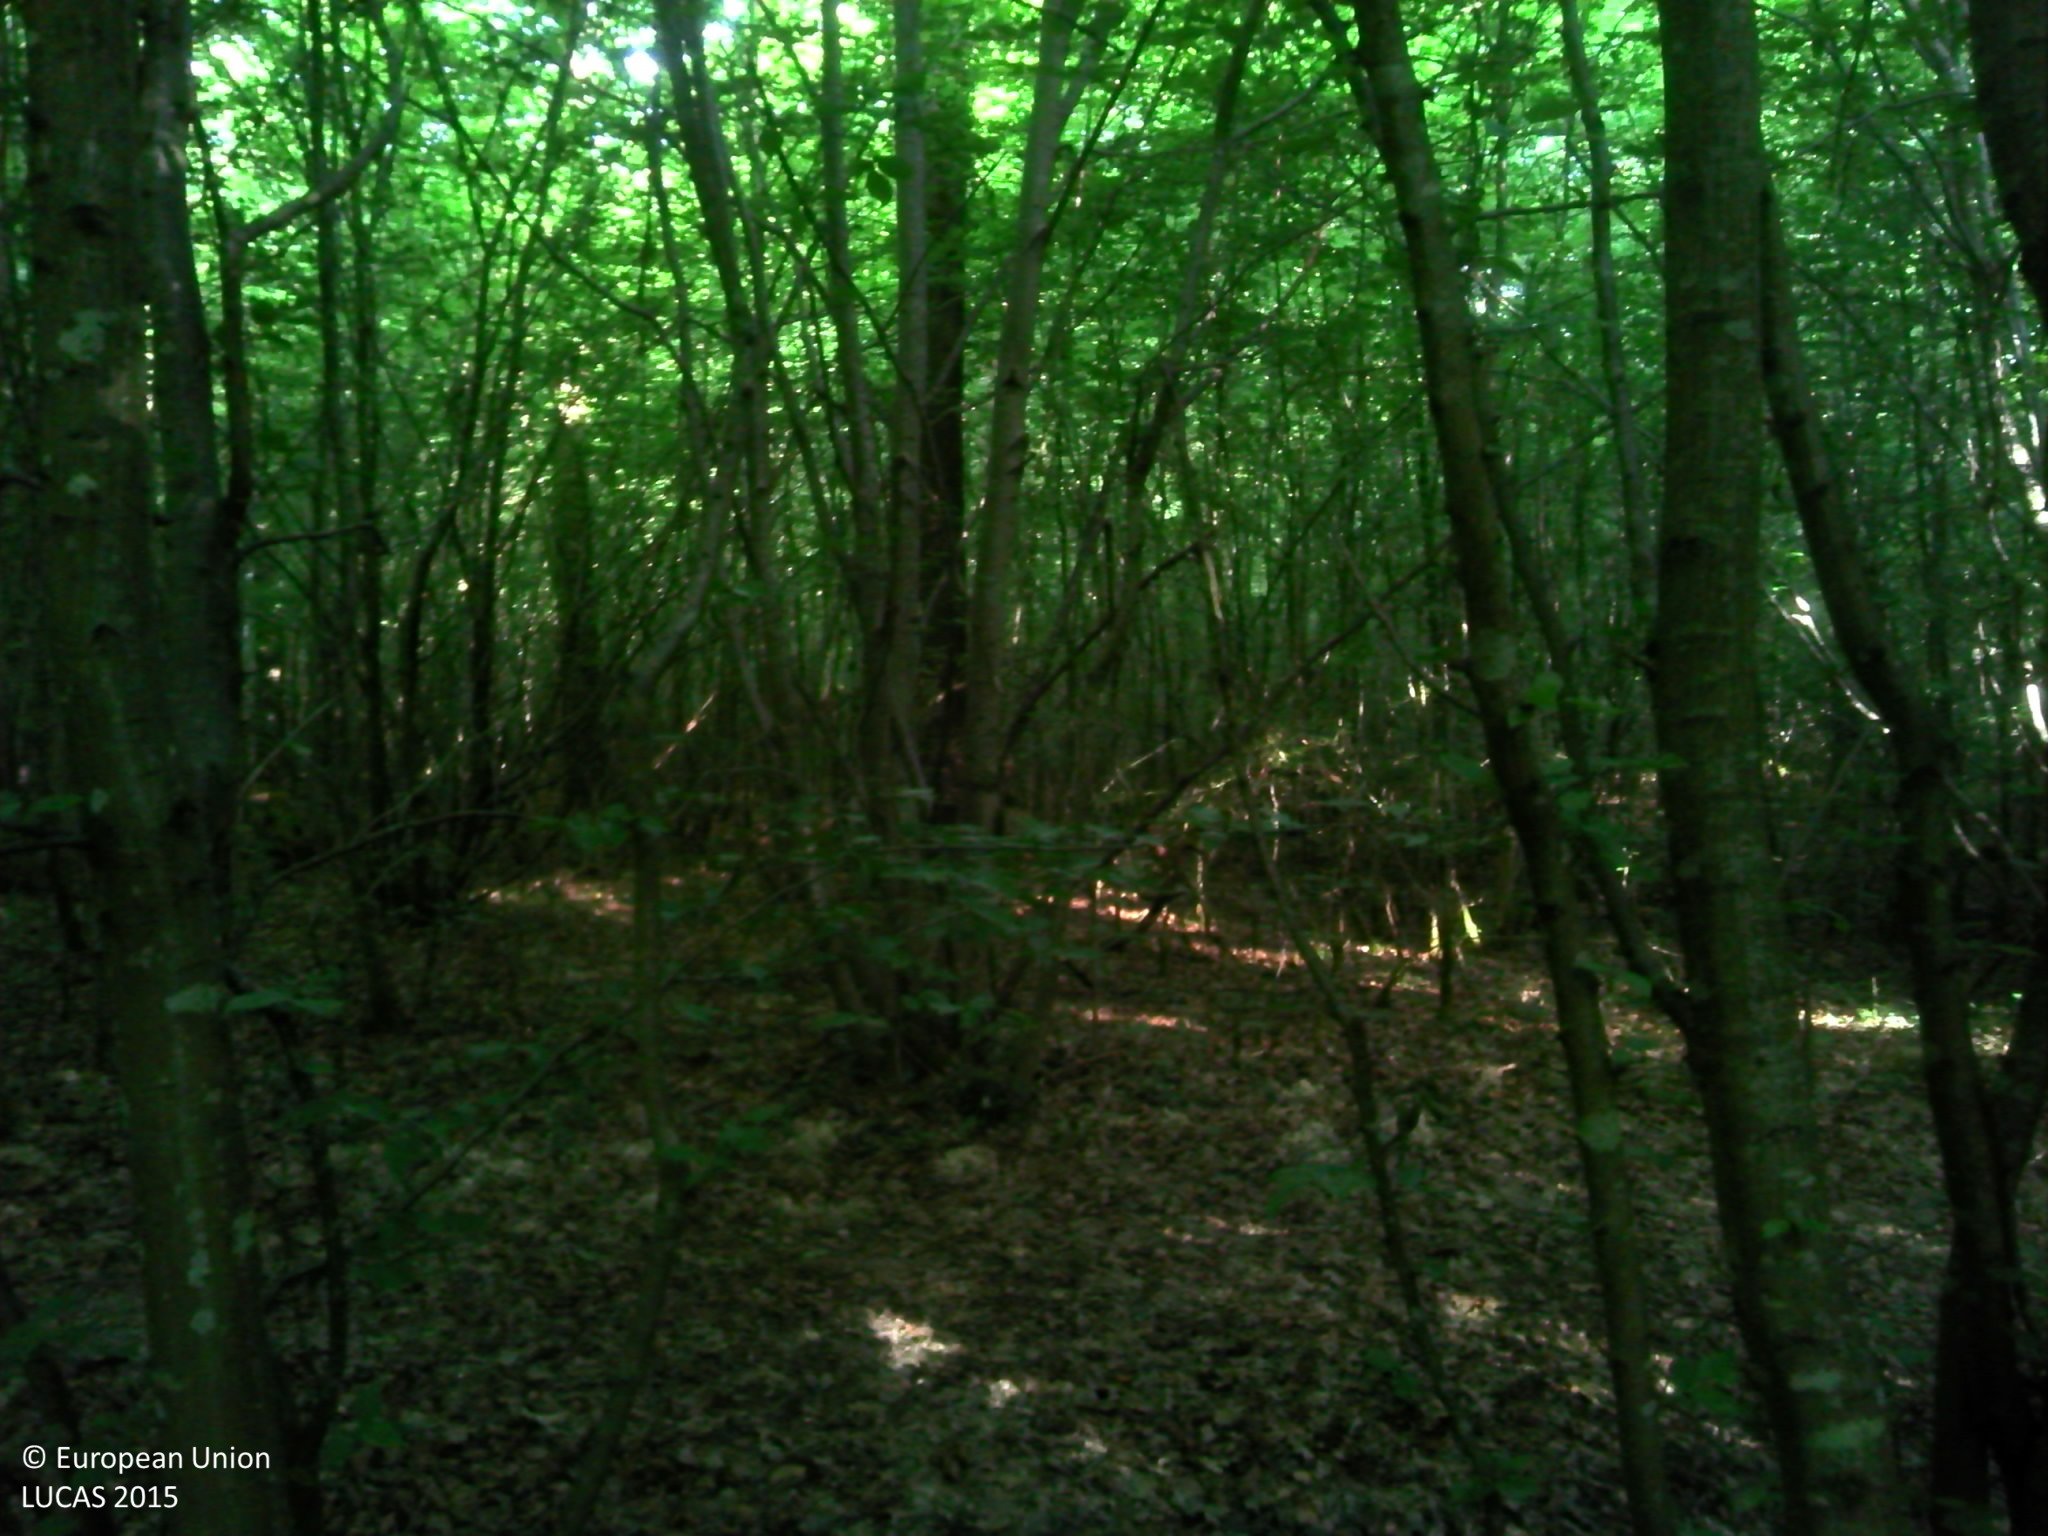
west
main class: Woodland
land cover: Broadleaved woodland
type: mesophytic deciduous forest
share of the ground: > 75 %
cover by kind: broadleaved forest trees 80 %, herbaceous plants 20 %
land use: Forestry
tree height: > 5 m
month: June
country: FR
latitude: 46.7470
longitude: 4.7785
